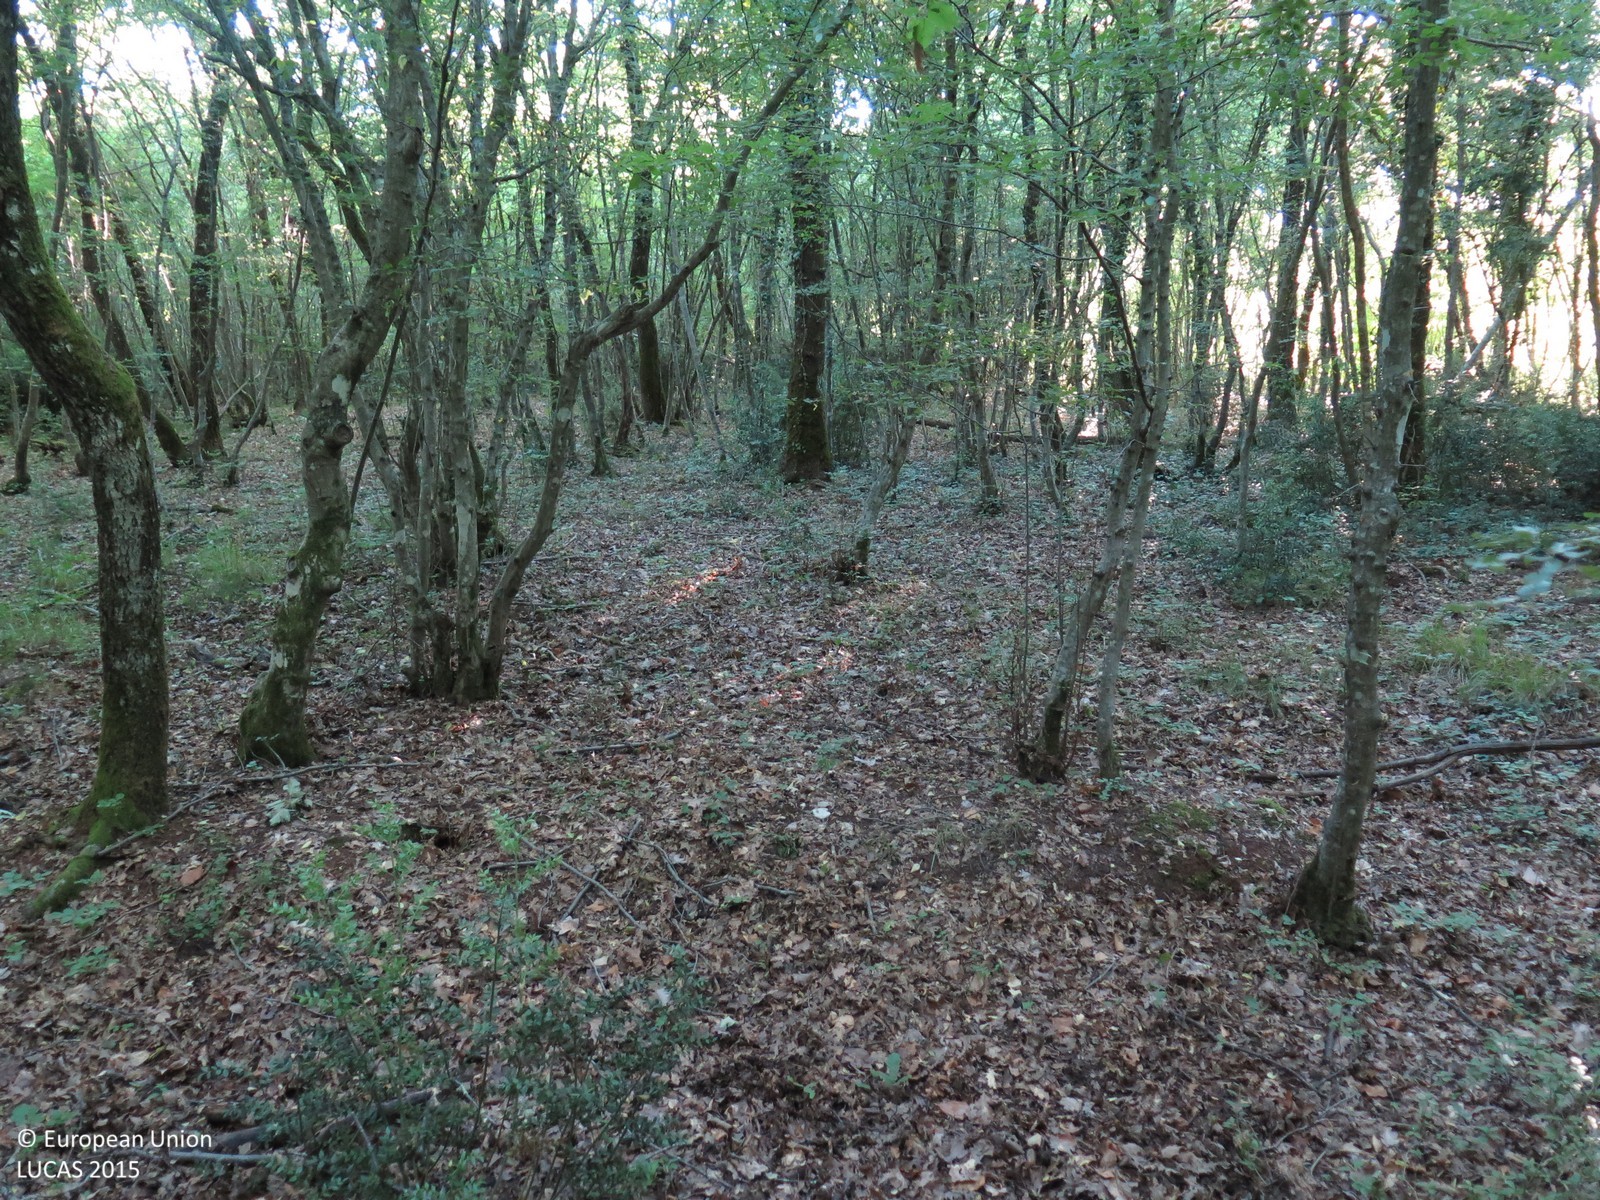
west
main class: Woodland
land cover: Broadleaved woodland
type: beech forest
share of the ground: > 75 %
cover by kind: broadleaved forest trees 100 %
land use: Semi-natural and natural areas not in use
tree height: > 5 m
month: June
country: HR
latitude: 45.1673
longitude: 13.7480
